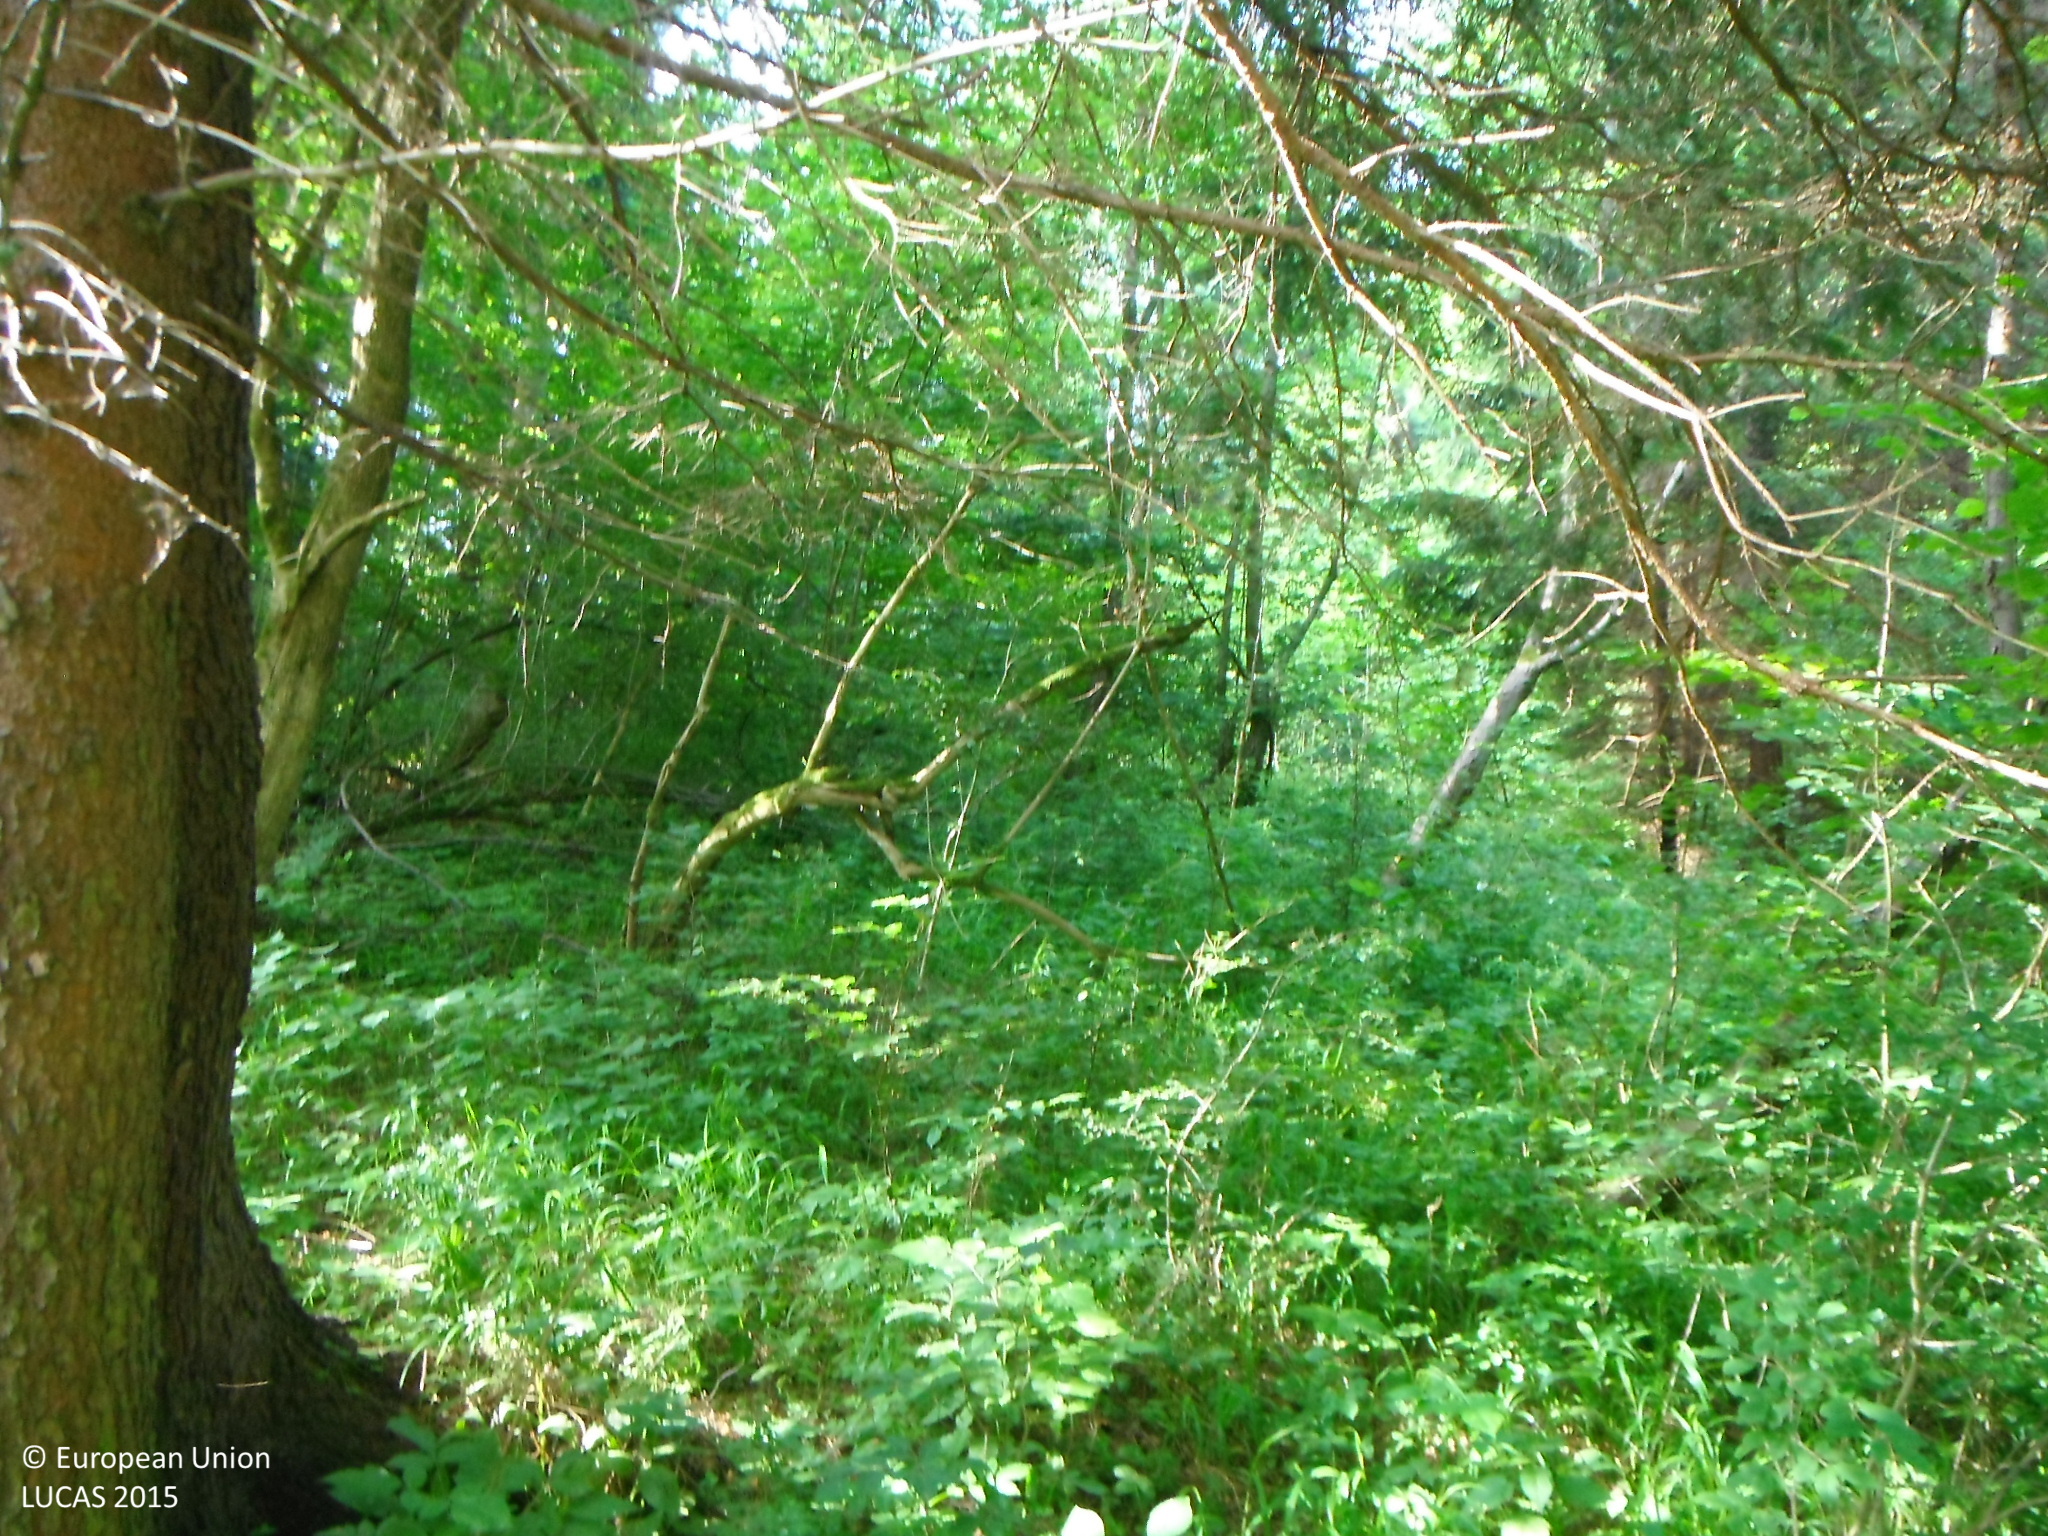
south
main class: Woodland
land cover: Spruce dominated mixed woodland
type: hemiboreal forest and nemoral coniferous forest and mixed broadleaved-coniferous forest
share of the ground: > 75 %
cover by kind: coniferous forest trees 50 %, broadleaved forest trees 50 %
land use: Forestry
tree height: > 5 m
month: July
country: SK
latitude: 49.2736
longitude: 19.3576
